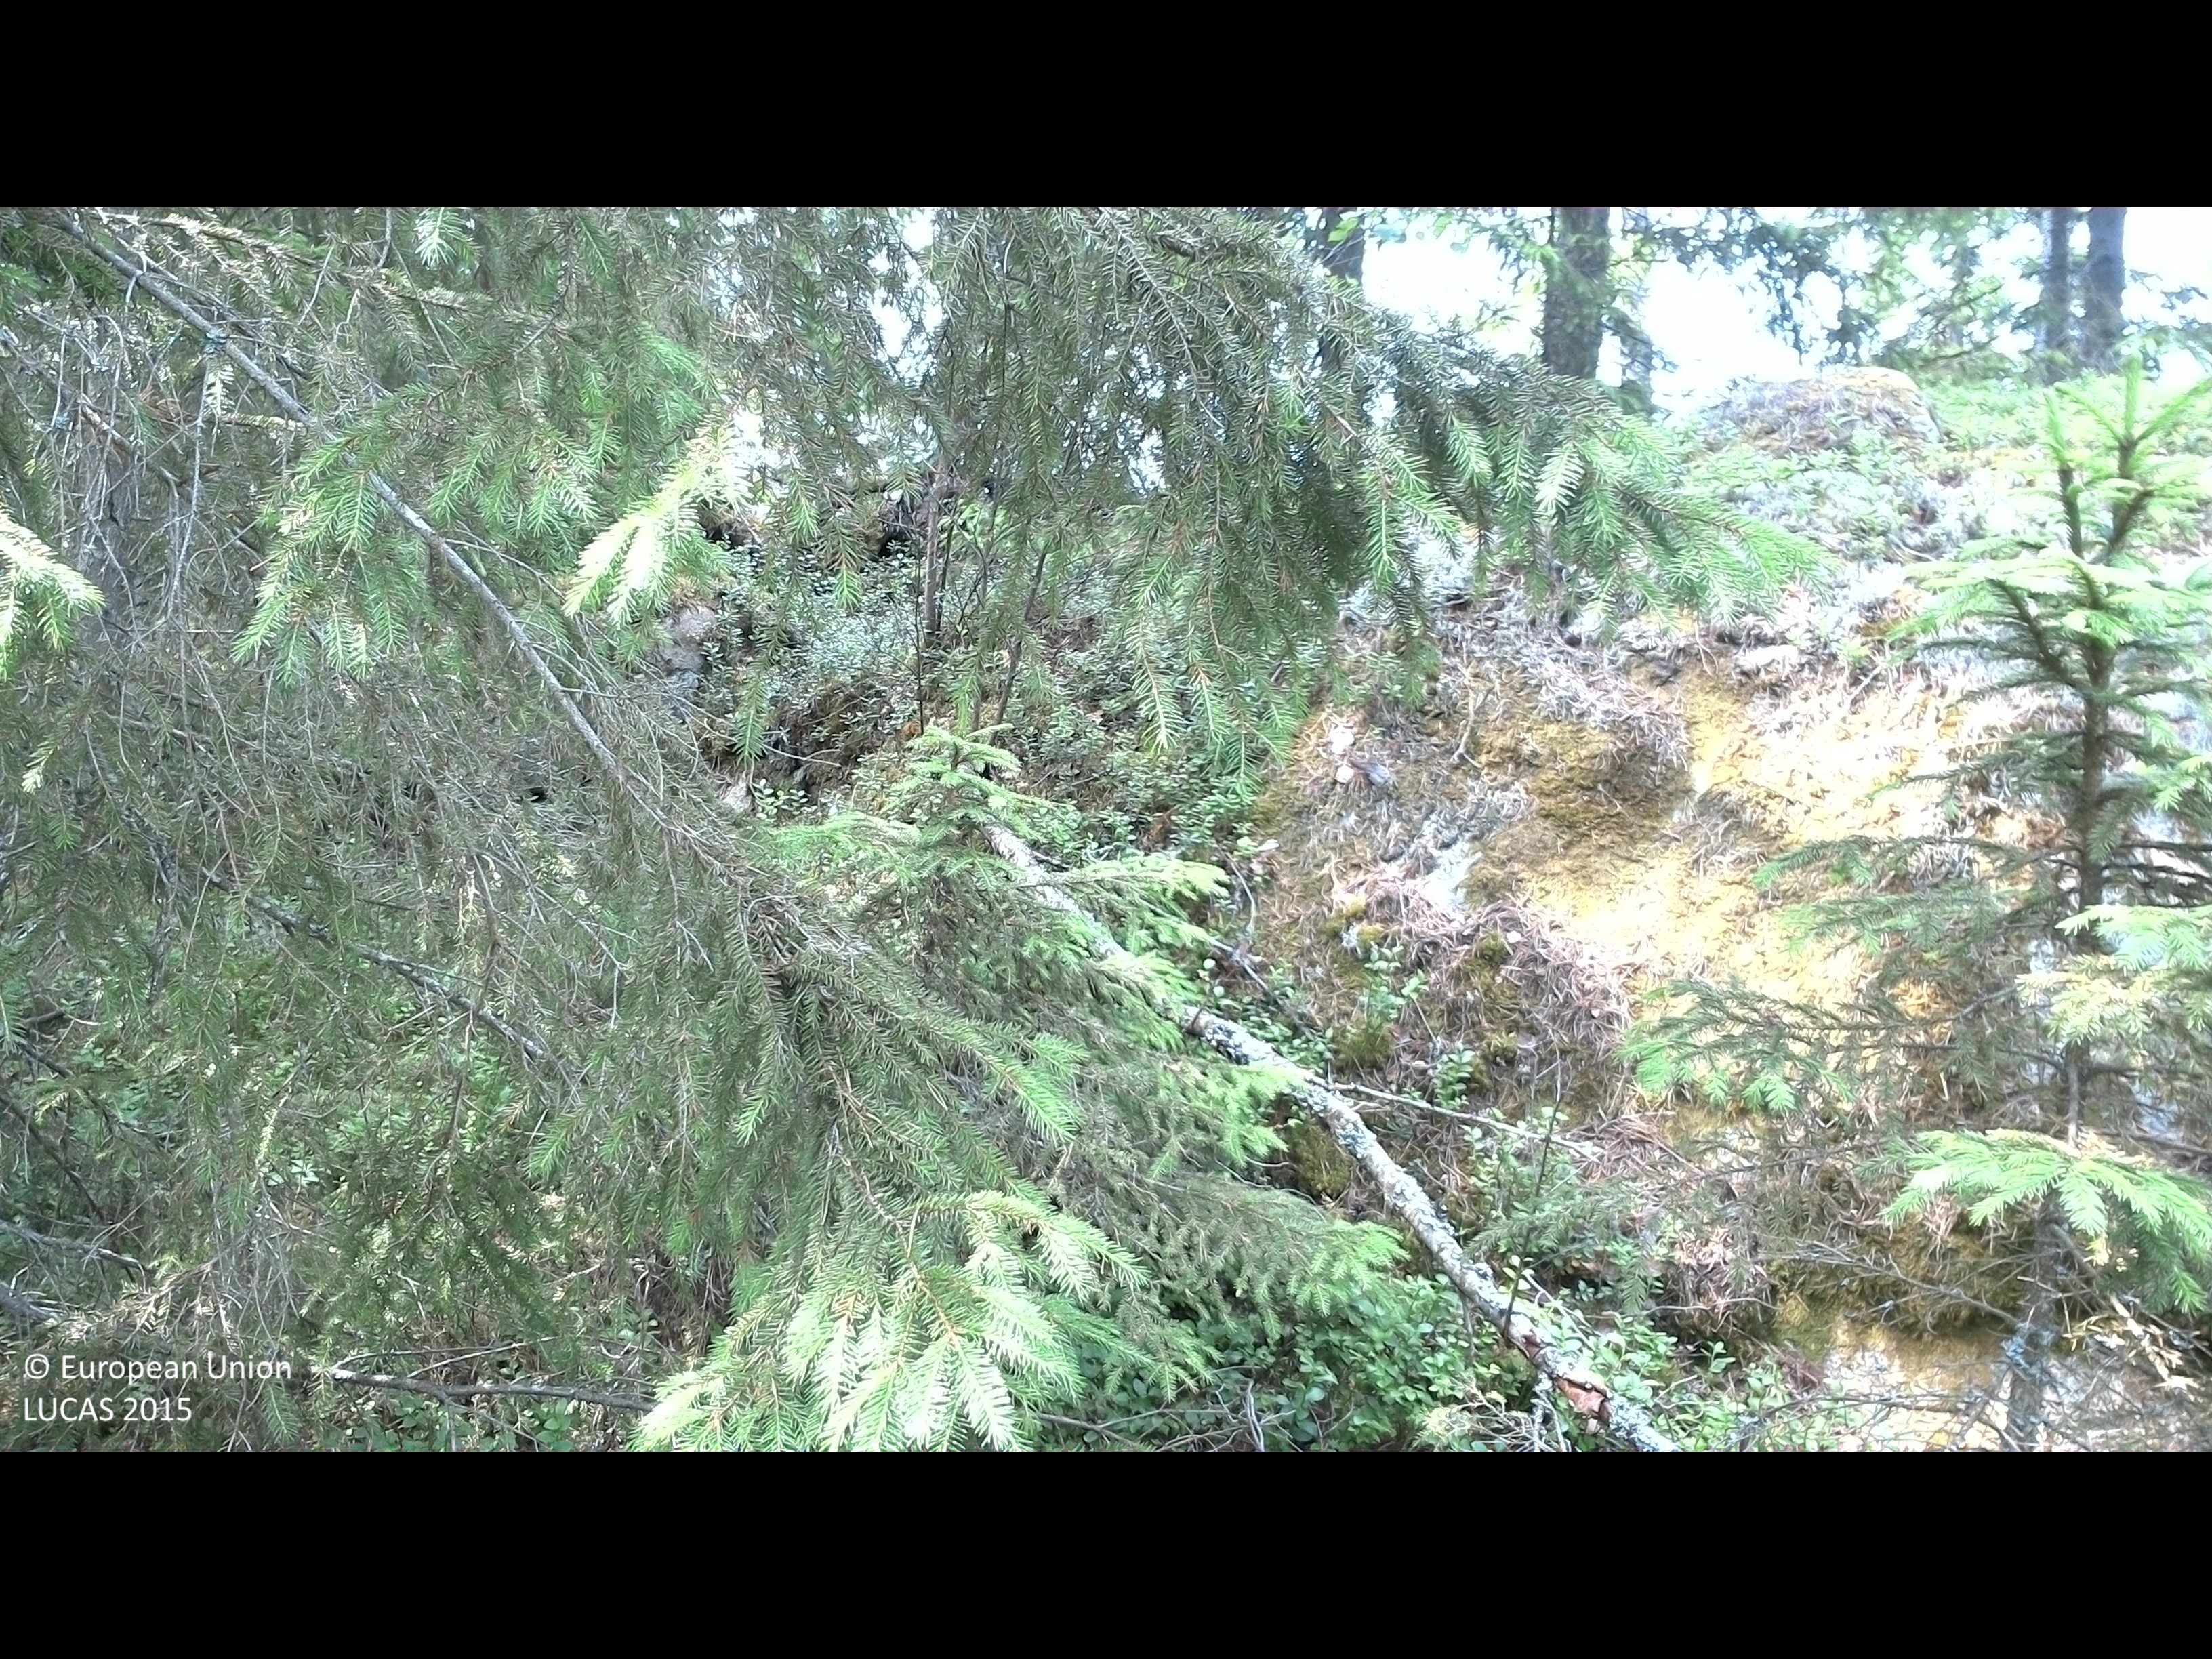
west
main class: Woodland
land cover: Pine dominated coniferous woodland
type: boreal forest
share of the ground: 50 - 75 %
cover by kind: coniferous forest trees 65 %, shrubs 20 %, broadleaved forest trees 5 %, herbaceous plants 5 %, lichens and mosses 5 %
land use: Forestry
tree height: > 5 m
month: July
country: SE
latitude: 56.3423
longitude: 15.4513
